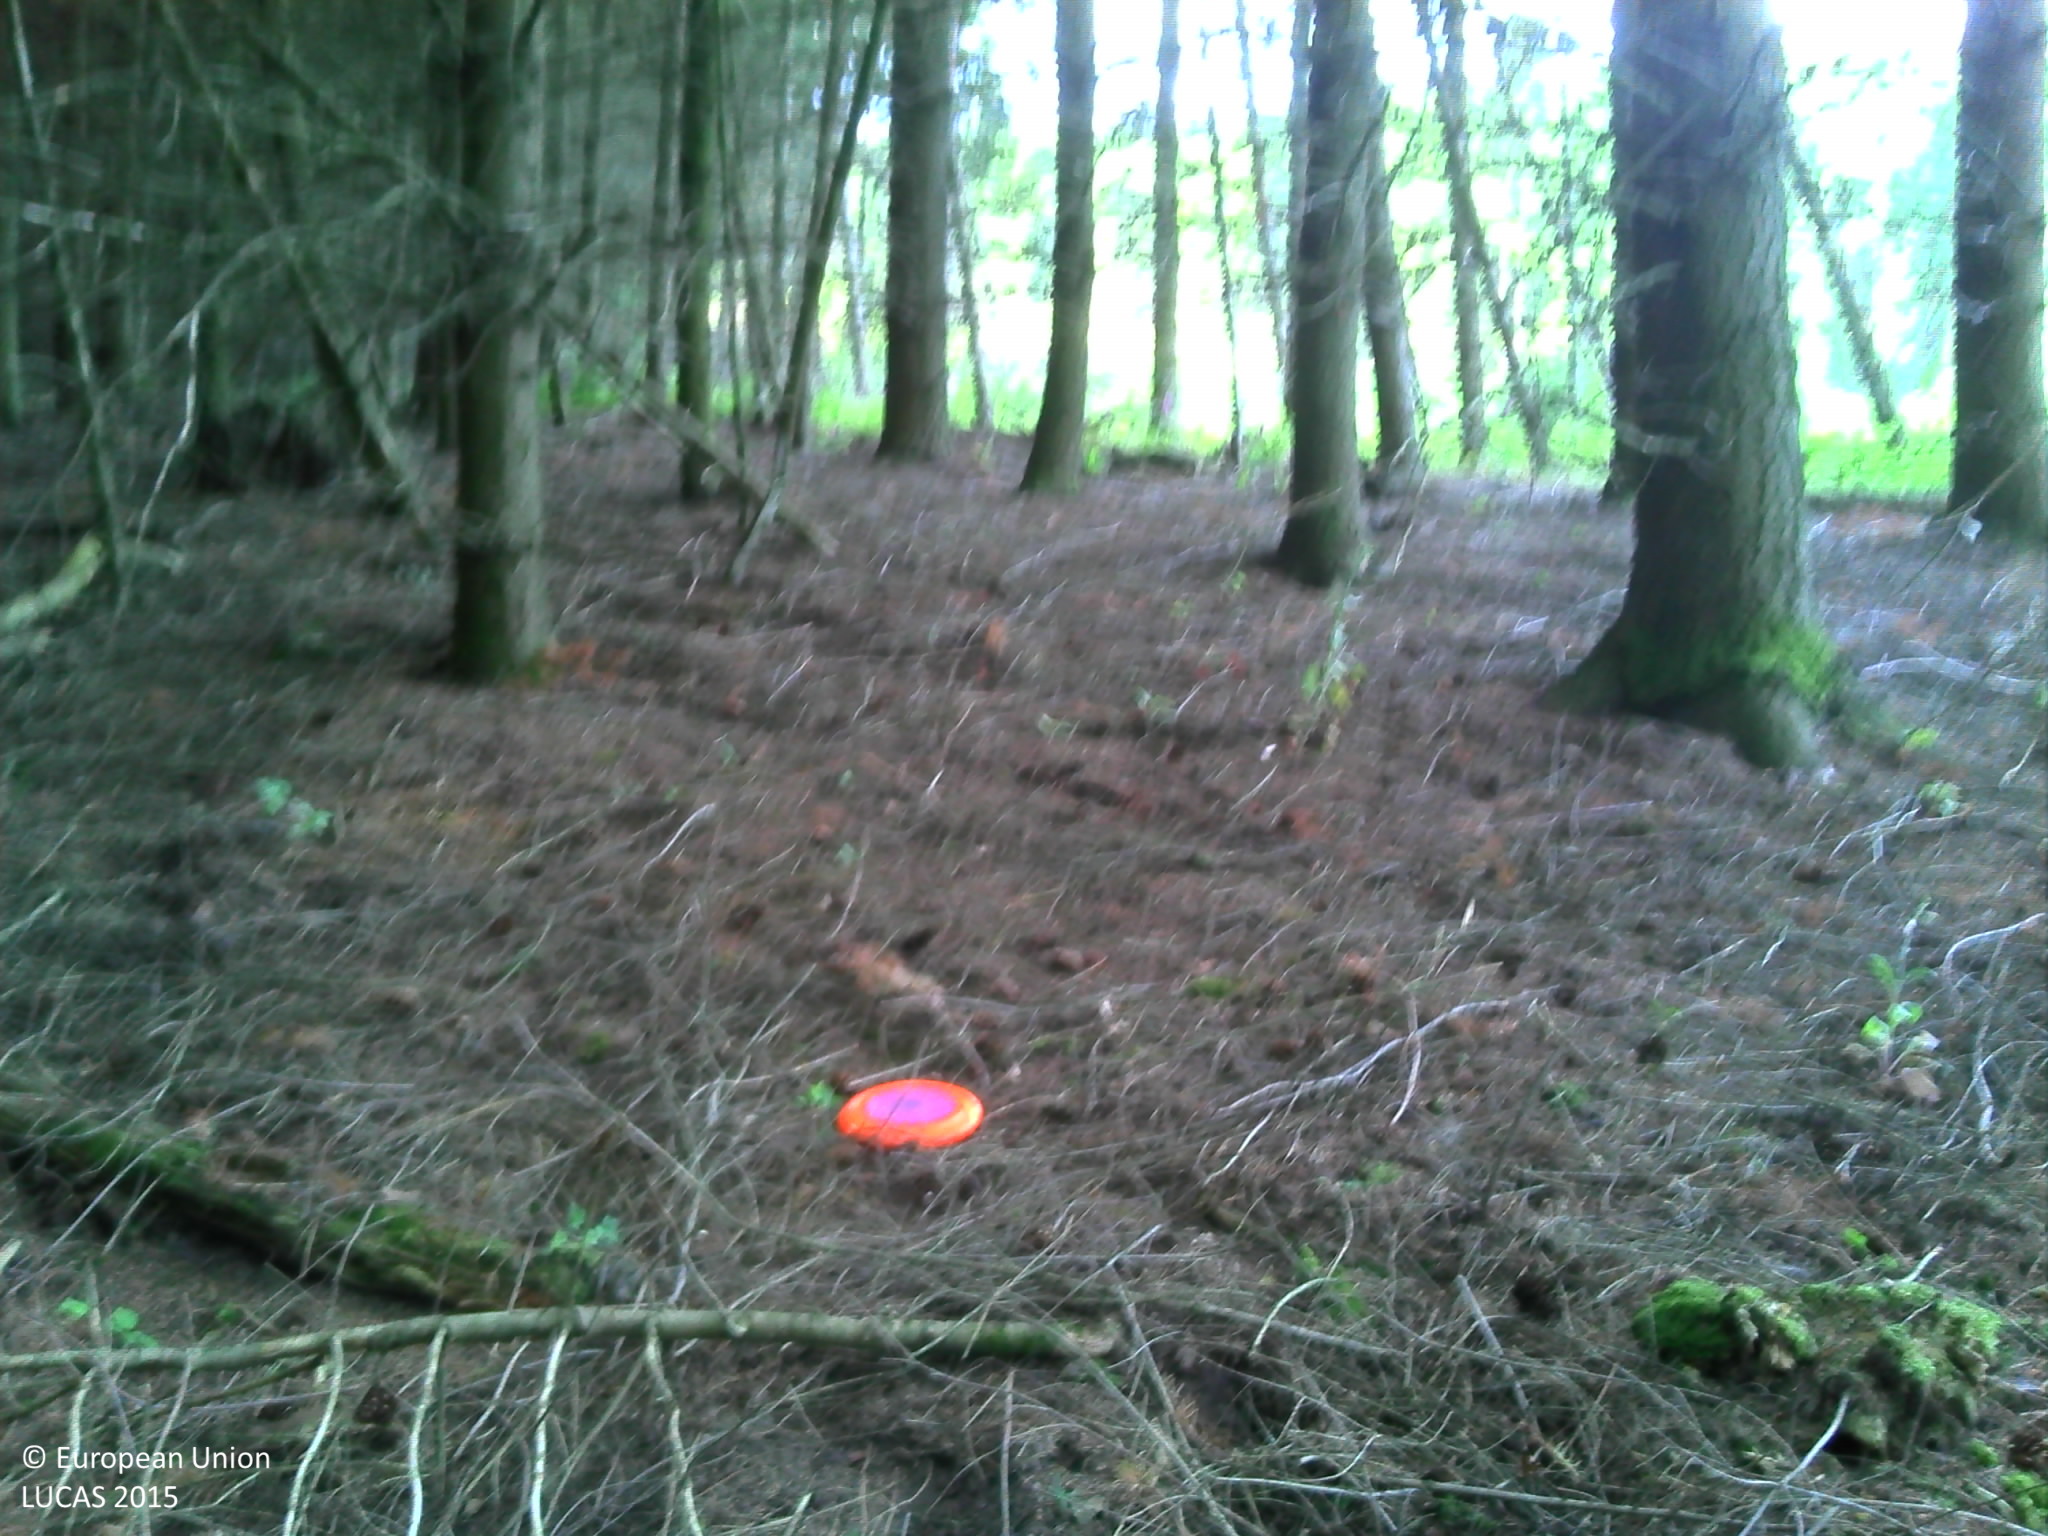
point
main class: Woodland
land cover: Spruce dominated coniferous woodland
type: exotic forest
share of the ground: > 75 %
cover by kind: coniferous forest trees 100 %
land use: Forestry
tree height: > 5 m
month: June
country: FR
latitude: 46.3324
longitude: 4.4287
